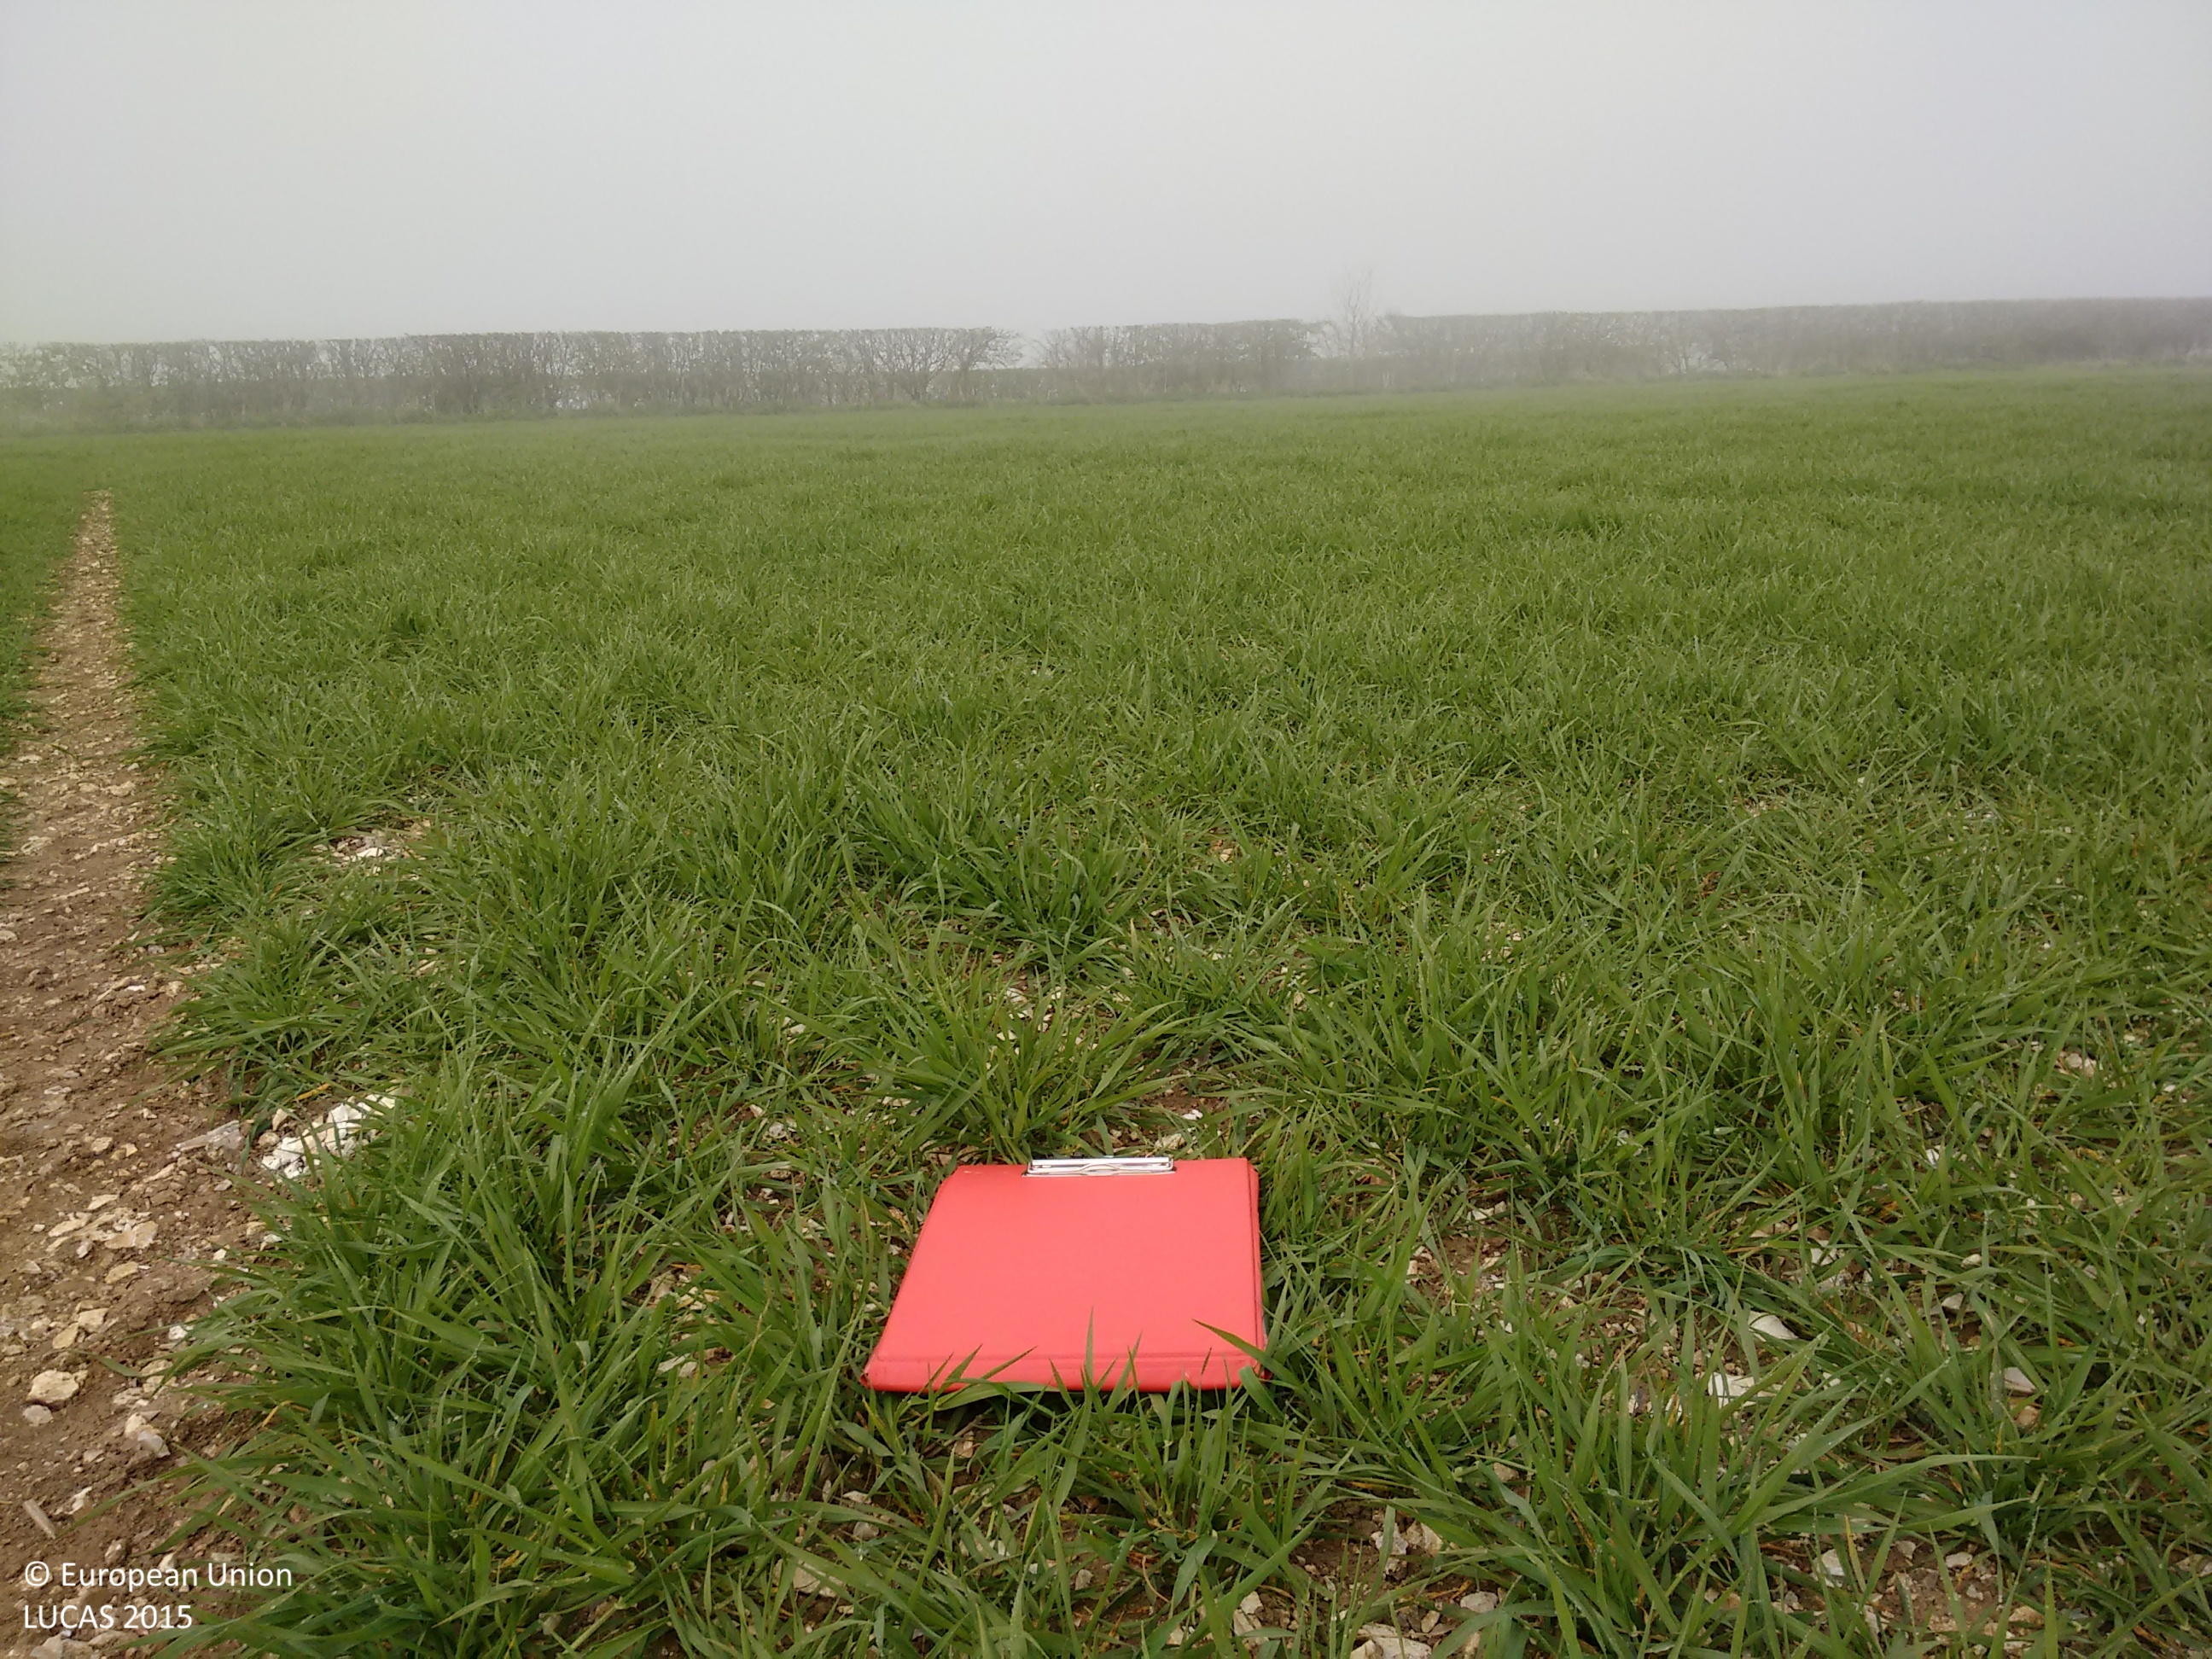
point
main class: Cropland
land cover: Barley
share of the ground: > 75 %
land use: Agriculture (excluding fallow land and kitchen gardens)
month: April
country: GB
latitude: 53.9914
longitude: -0.7622
